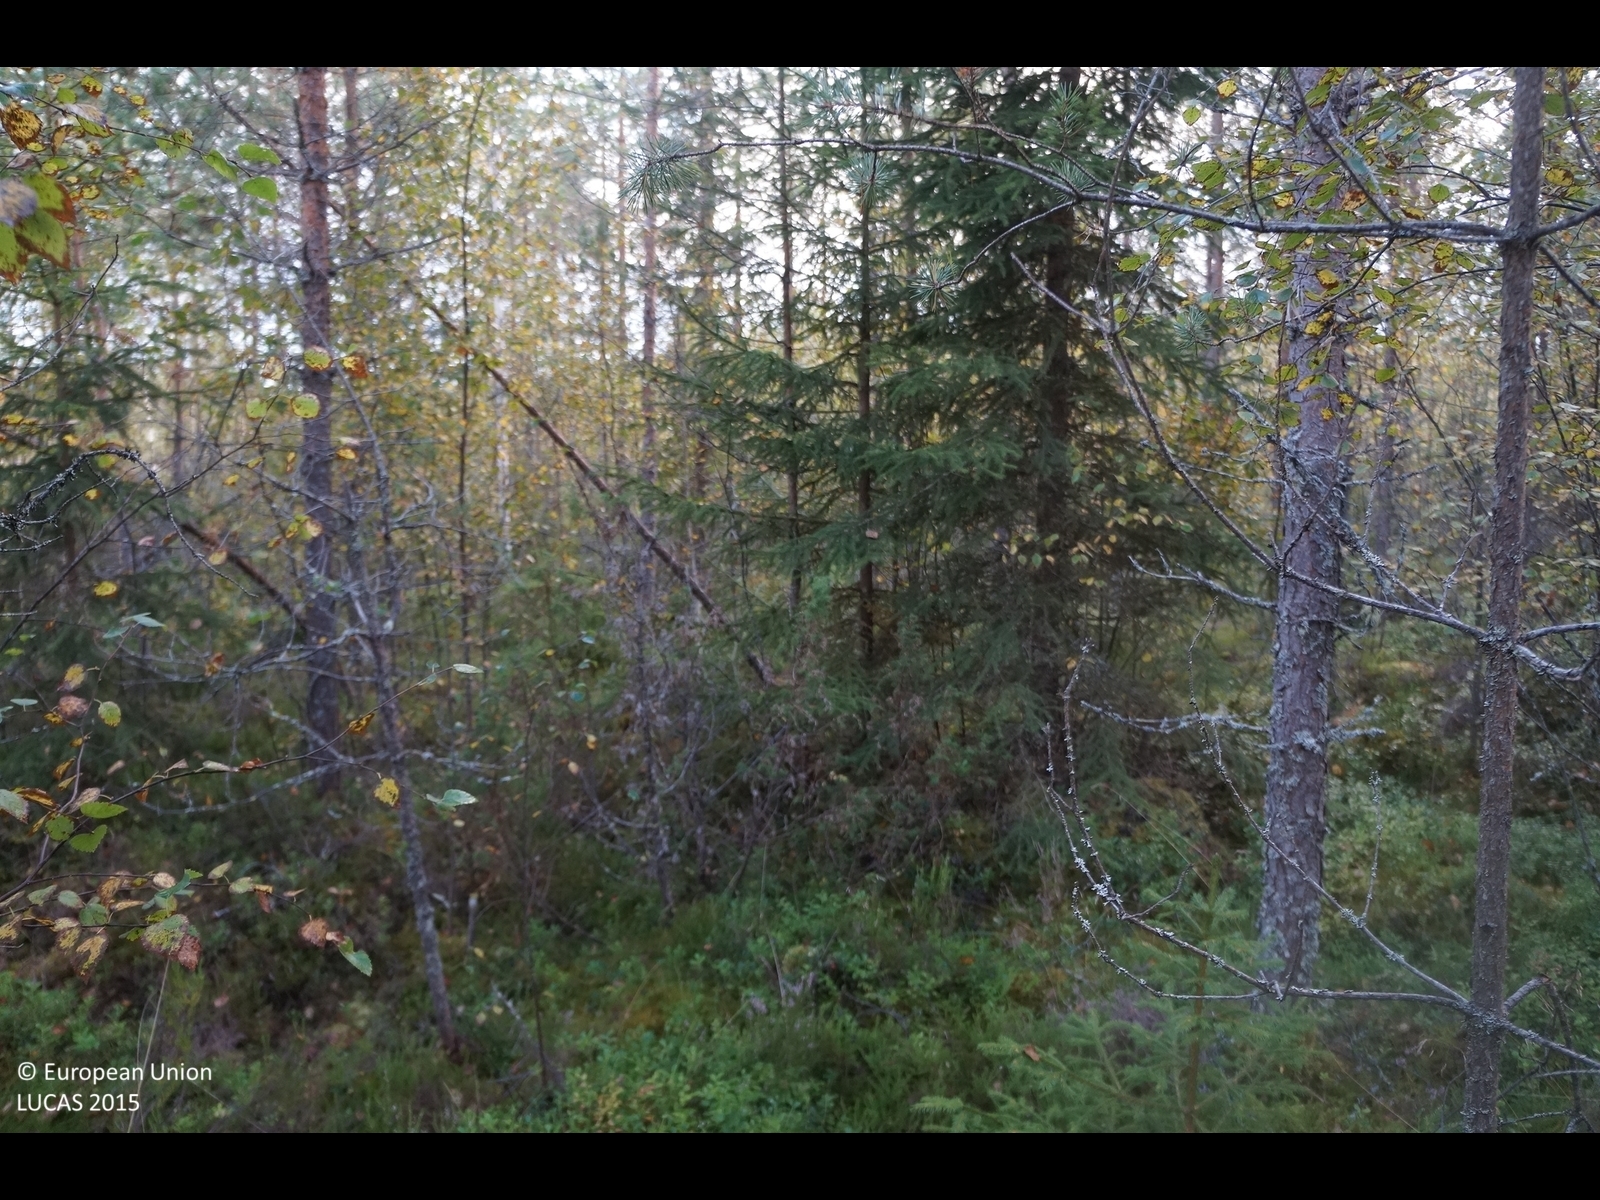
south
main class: Woodland
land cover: Pine dominated coniferous woodland
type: boreal forest
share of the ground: 50 - 75 %
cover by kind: coniferous forest trees 70 %, shrubs 20 %, herbaceous plants 5 %, lichens and mosses 5 %
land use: Forestry
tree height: > 5 m
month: September
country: FI
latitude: 63.8786
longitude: 24.2606
